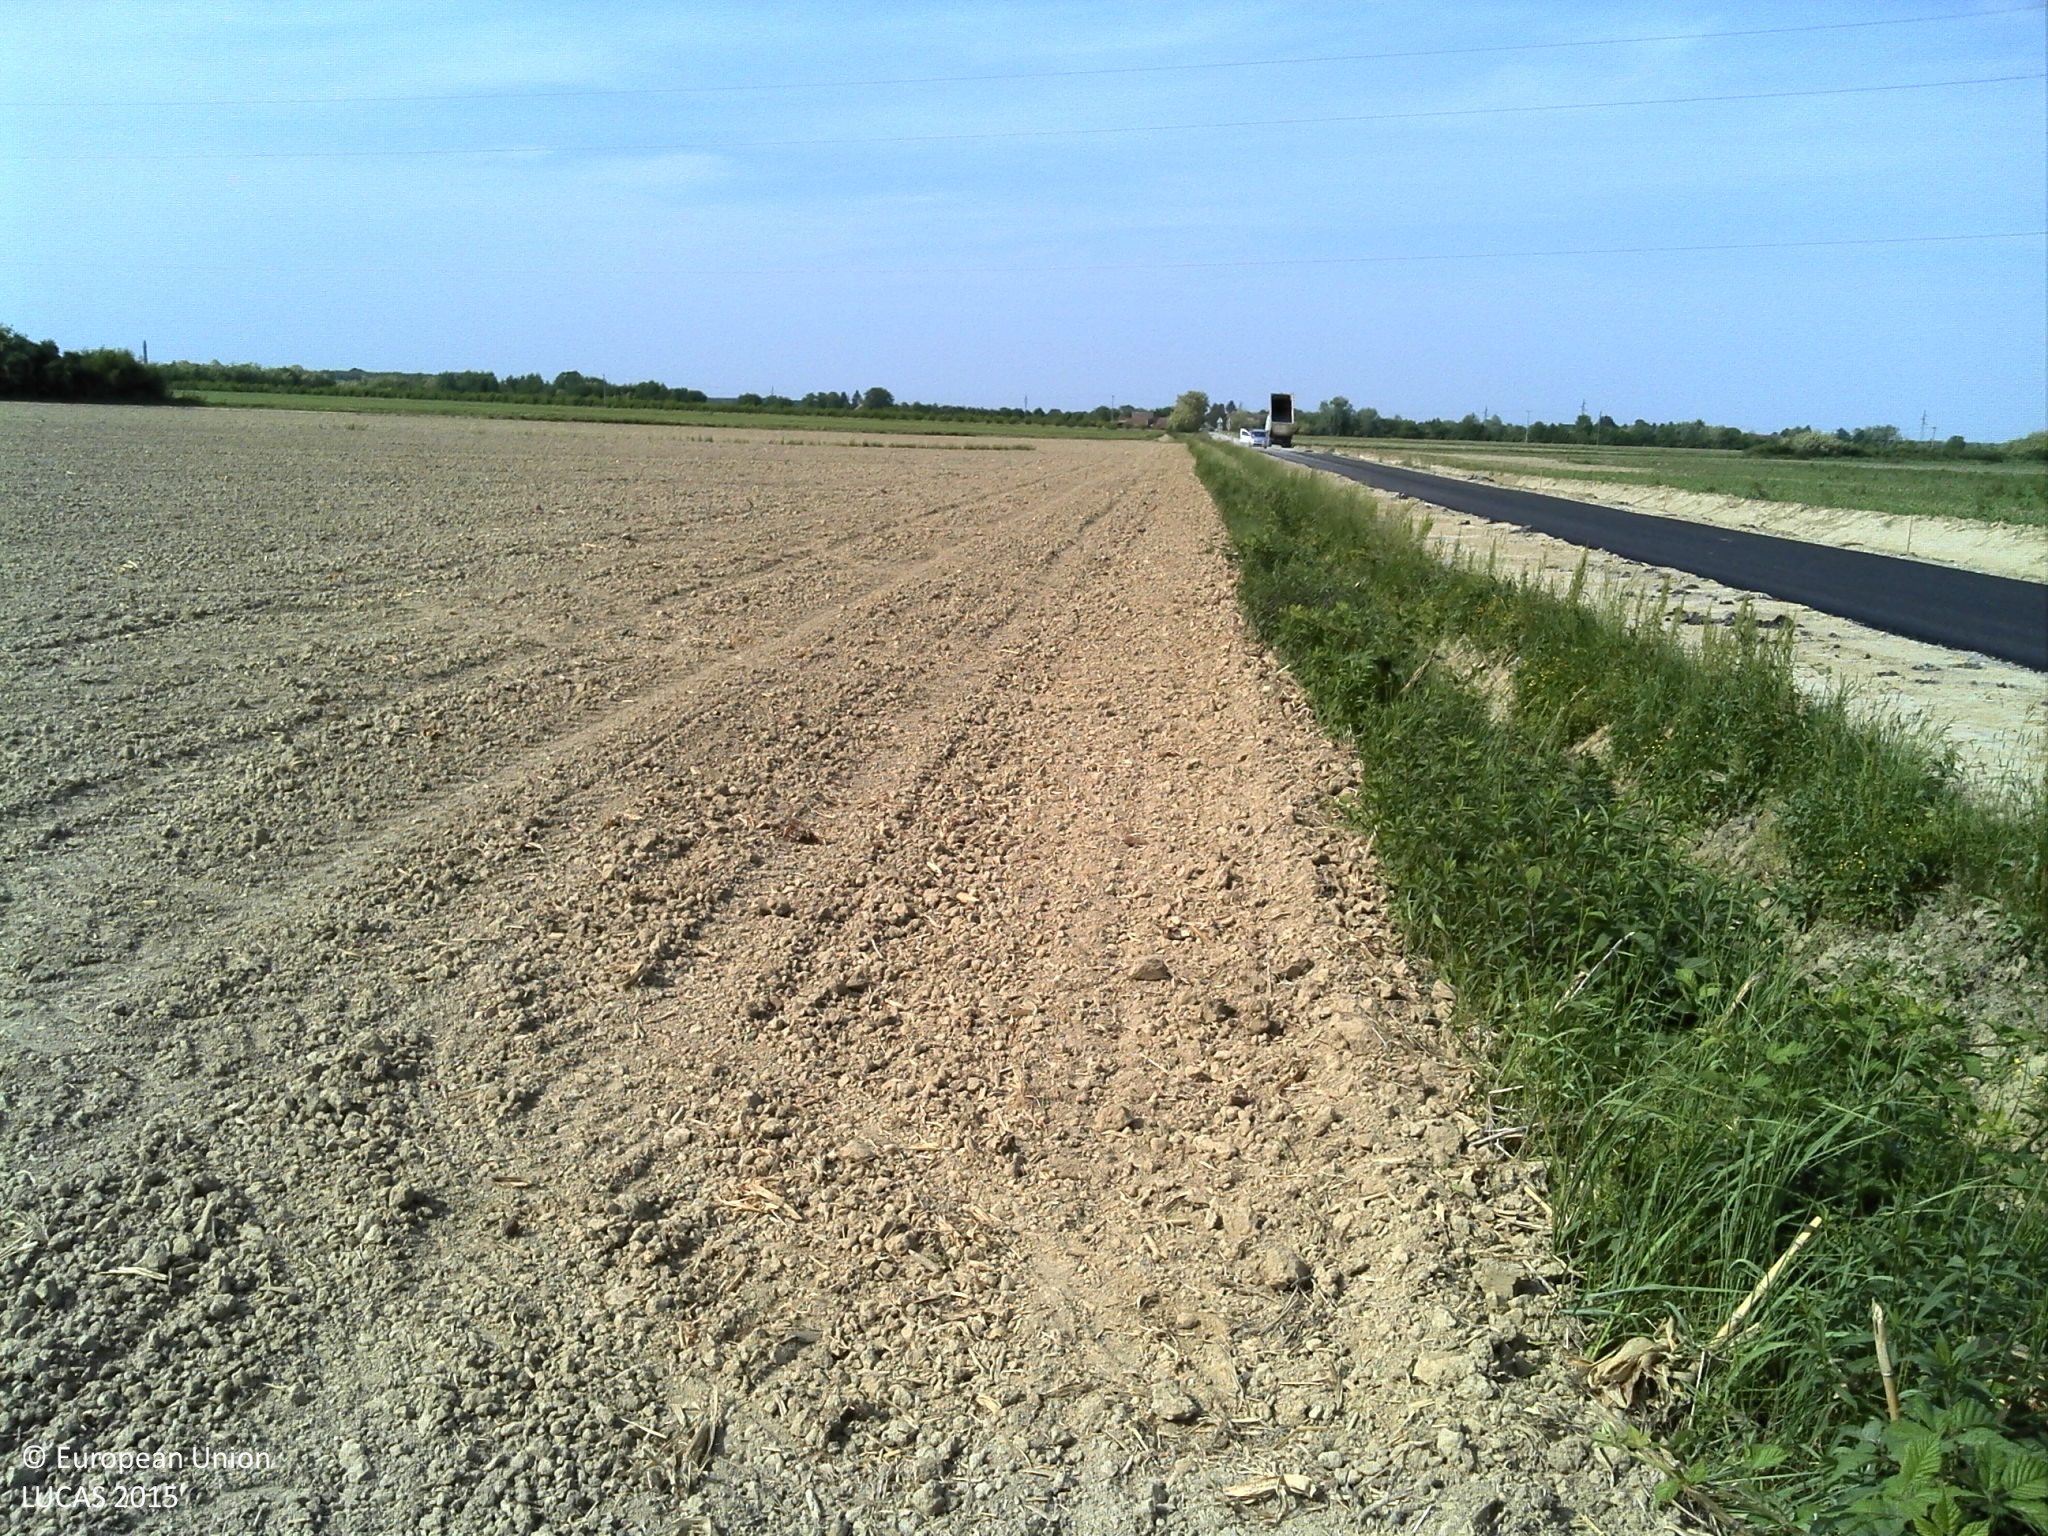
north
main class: Cropland
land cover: Maize
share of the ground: < 10 %
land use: Agriculture (excluding fallow land and kitchen gardens)
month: May
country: HR
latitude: 45.5220
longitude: 18.0570
